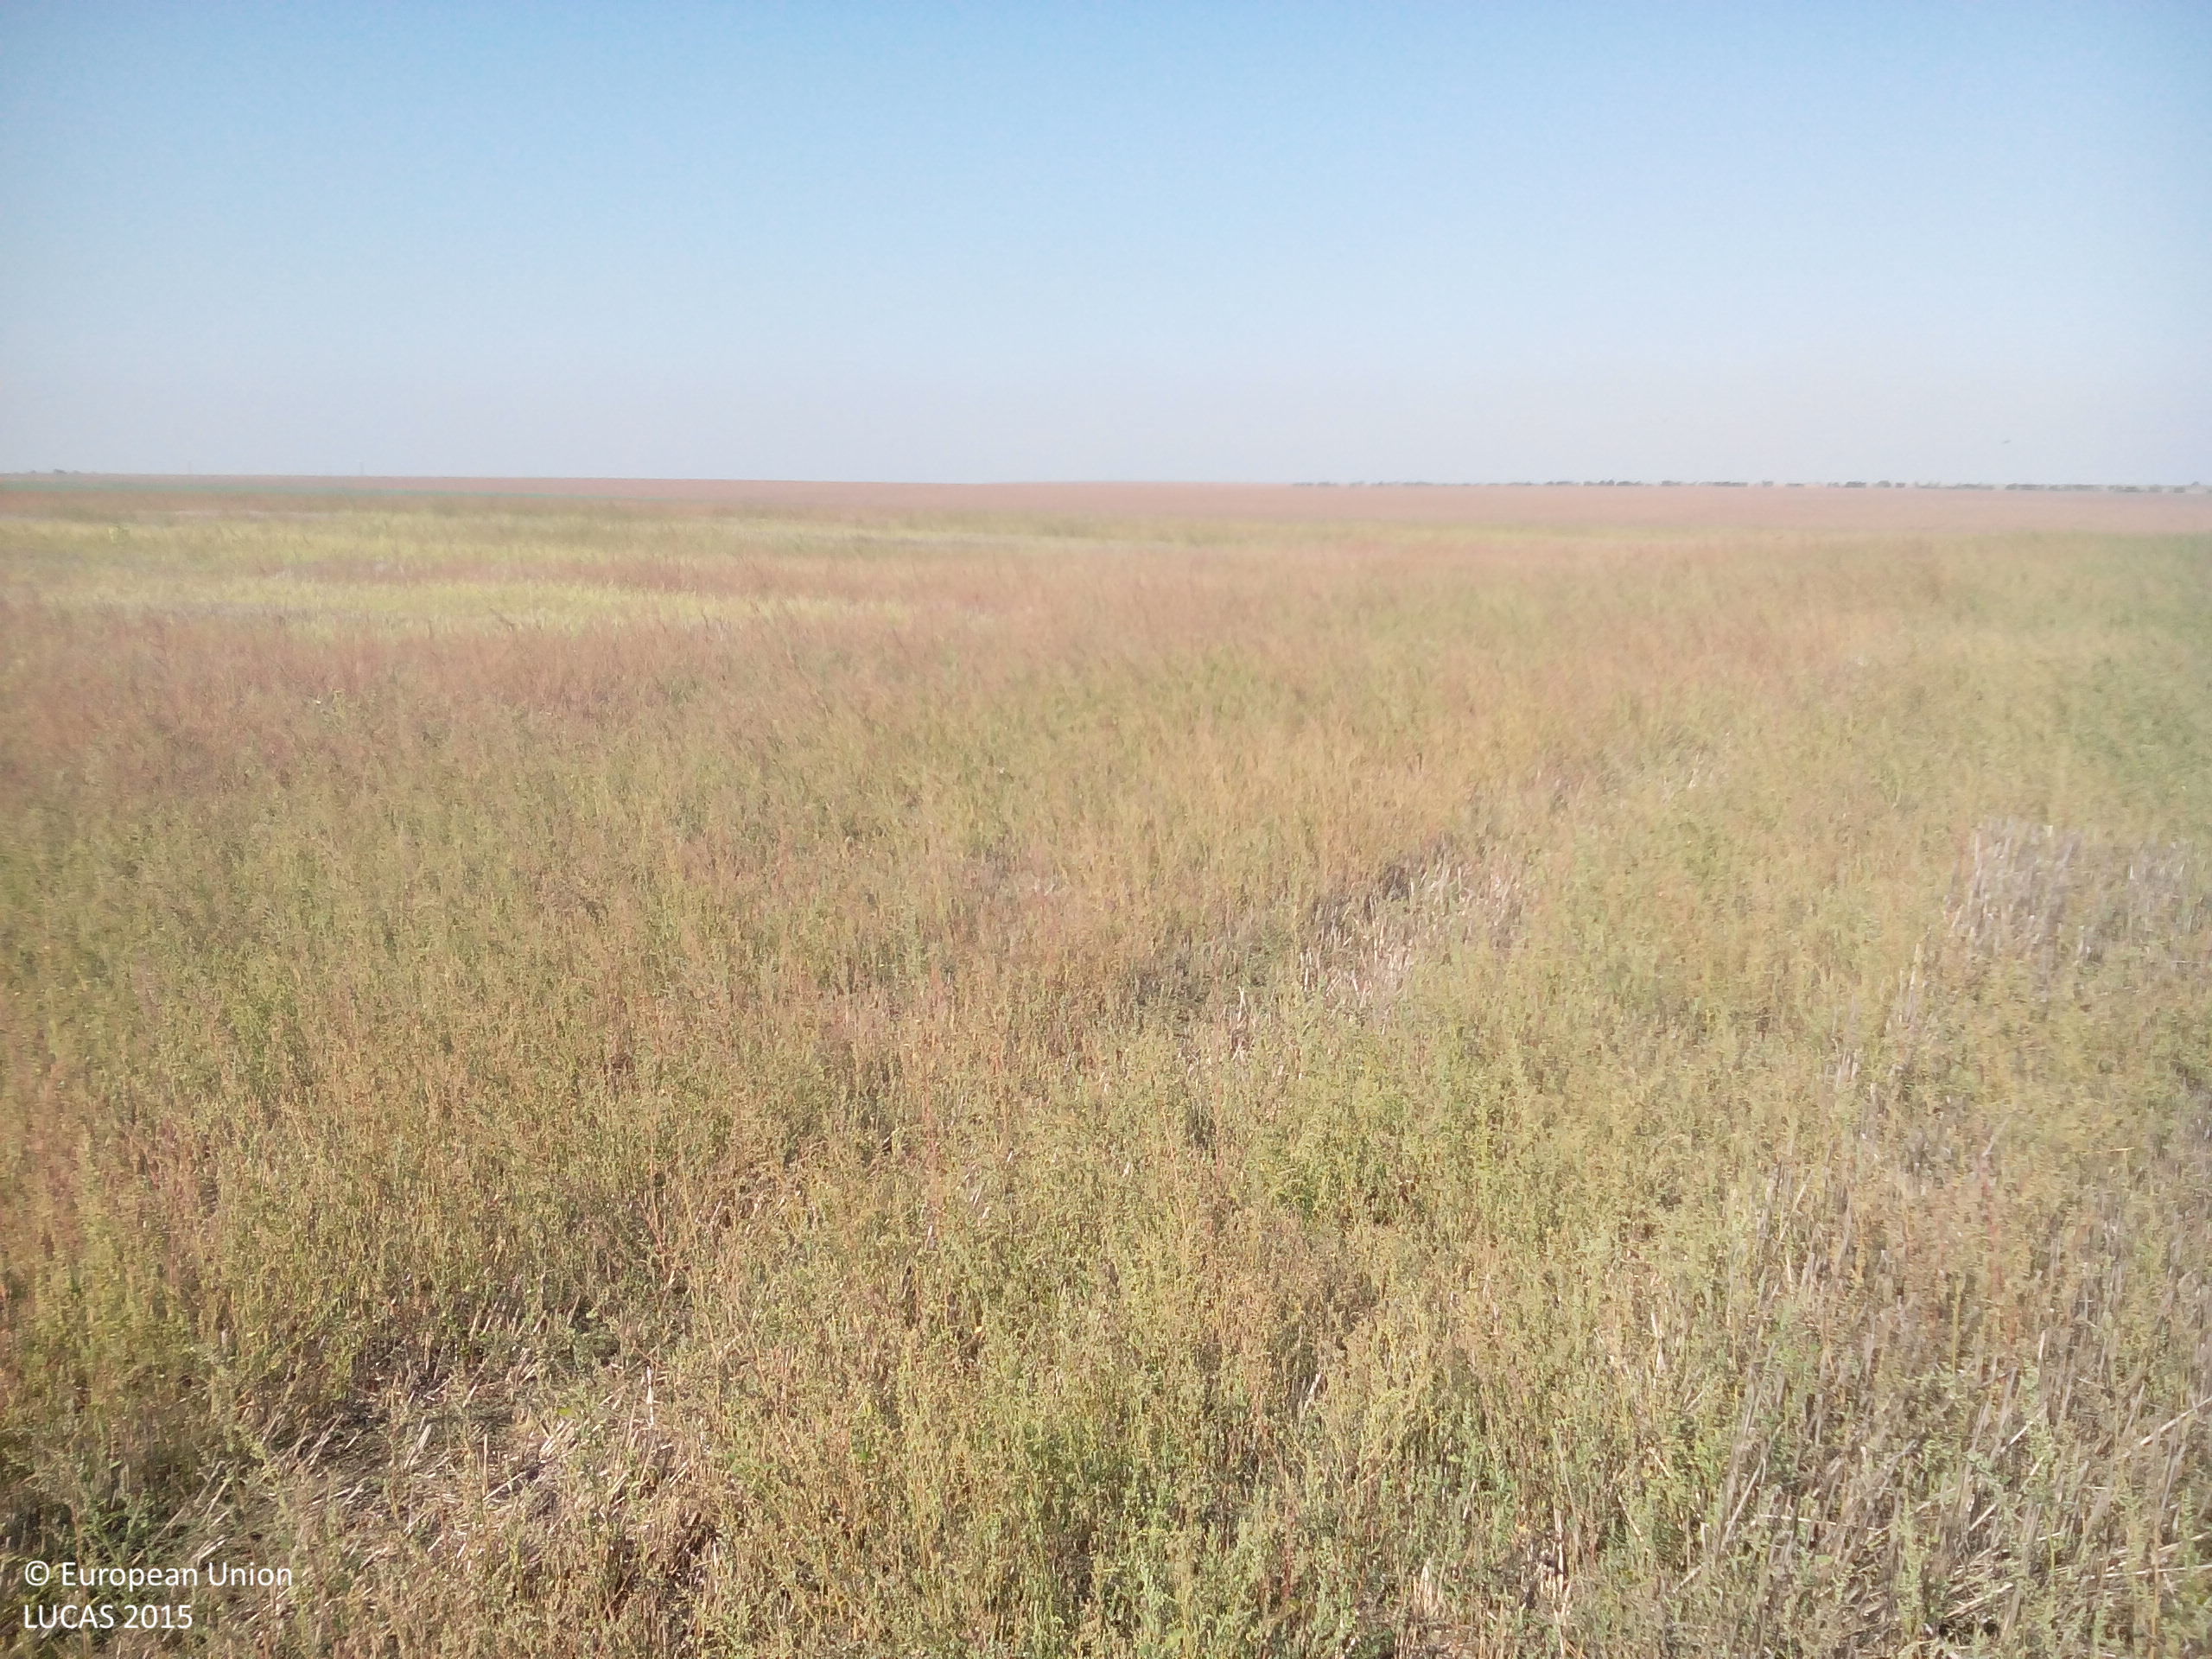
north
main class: Cropland
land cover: Common wheat
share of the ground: 10 - 25 %
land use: Agriculture (excluding fallow land and kitchen gardens)
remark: Harvested field
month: October
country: BG
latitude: 43.5499
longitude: 23.6757
